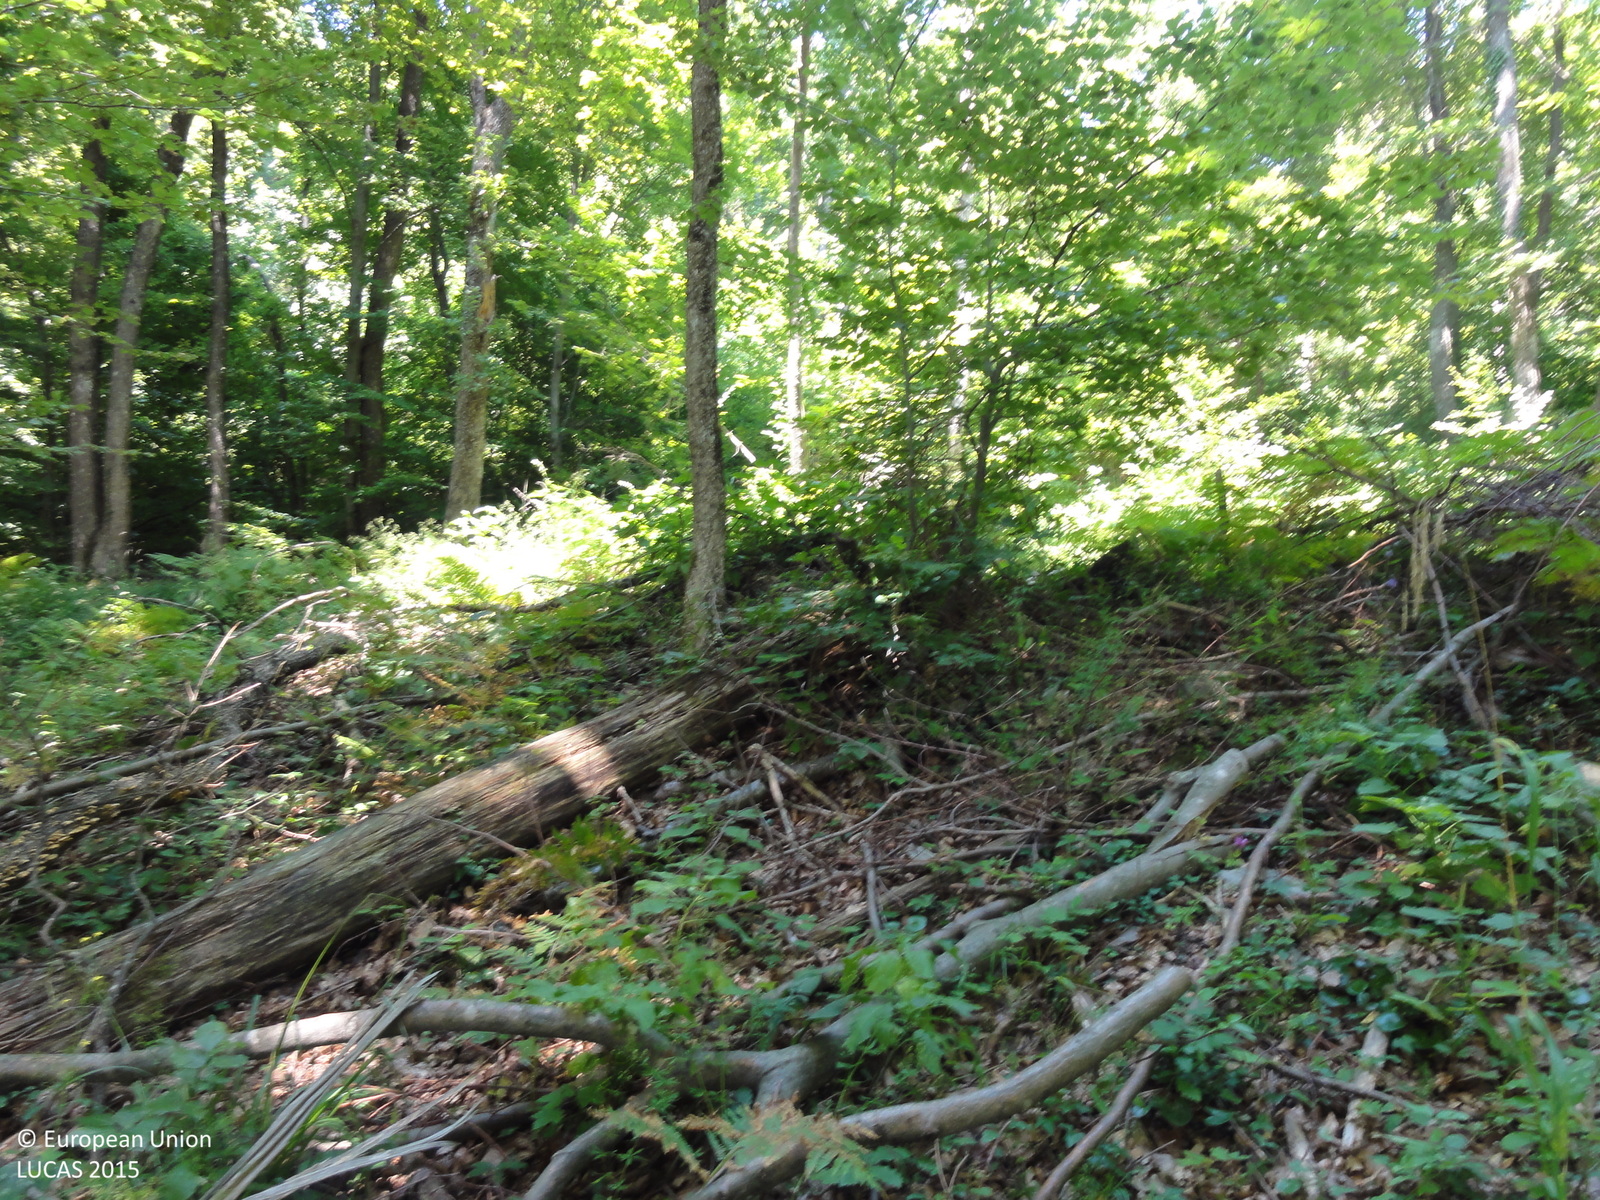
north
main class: Woodland
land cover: Broadleaved woodland
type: beech forest
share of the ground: > 75 %
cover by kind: broadleaved forest trees 100 %
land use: Forestry
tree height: > 5 m
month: August
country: SI
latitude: 45.9988
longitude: 15.0197
